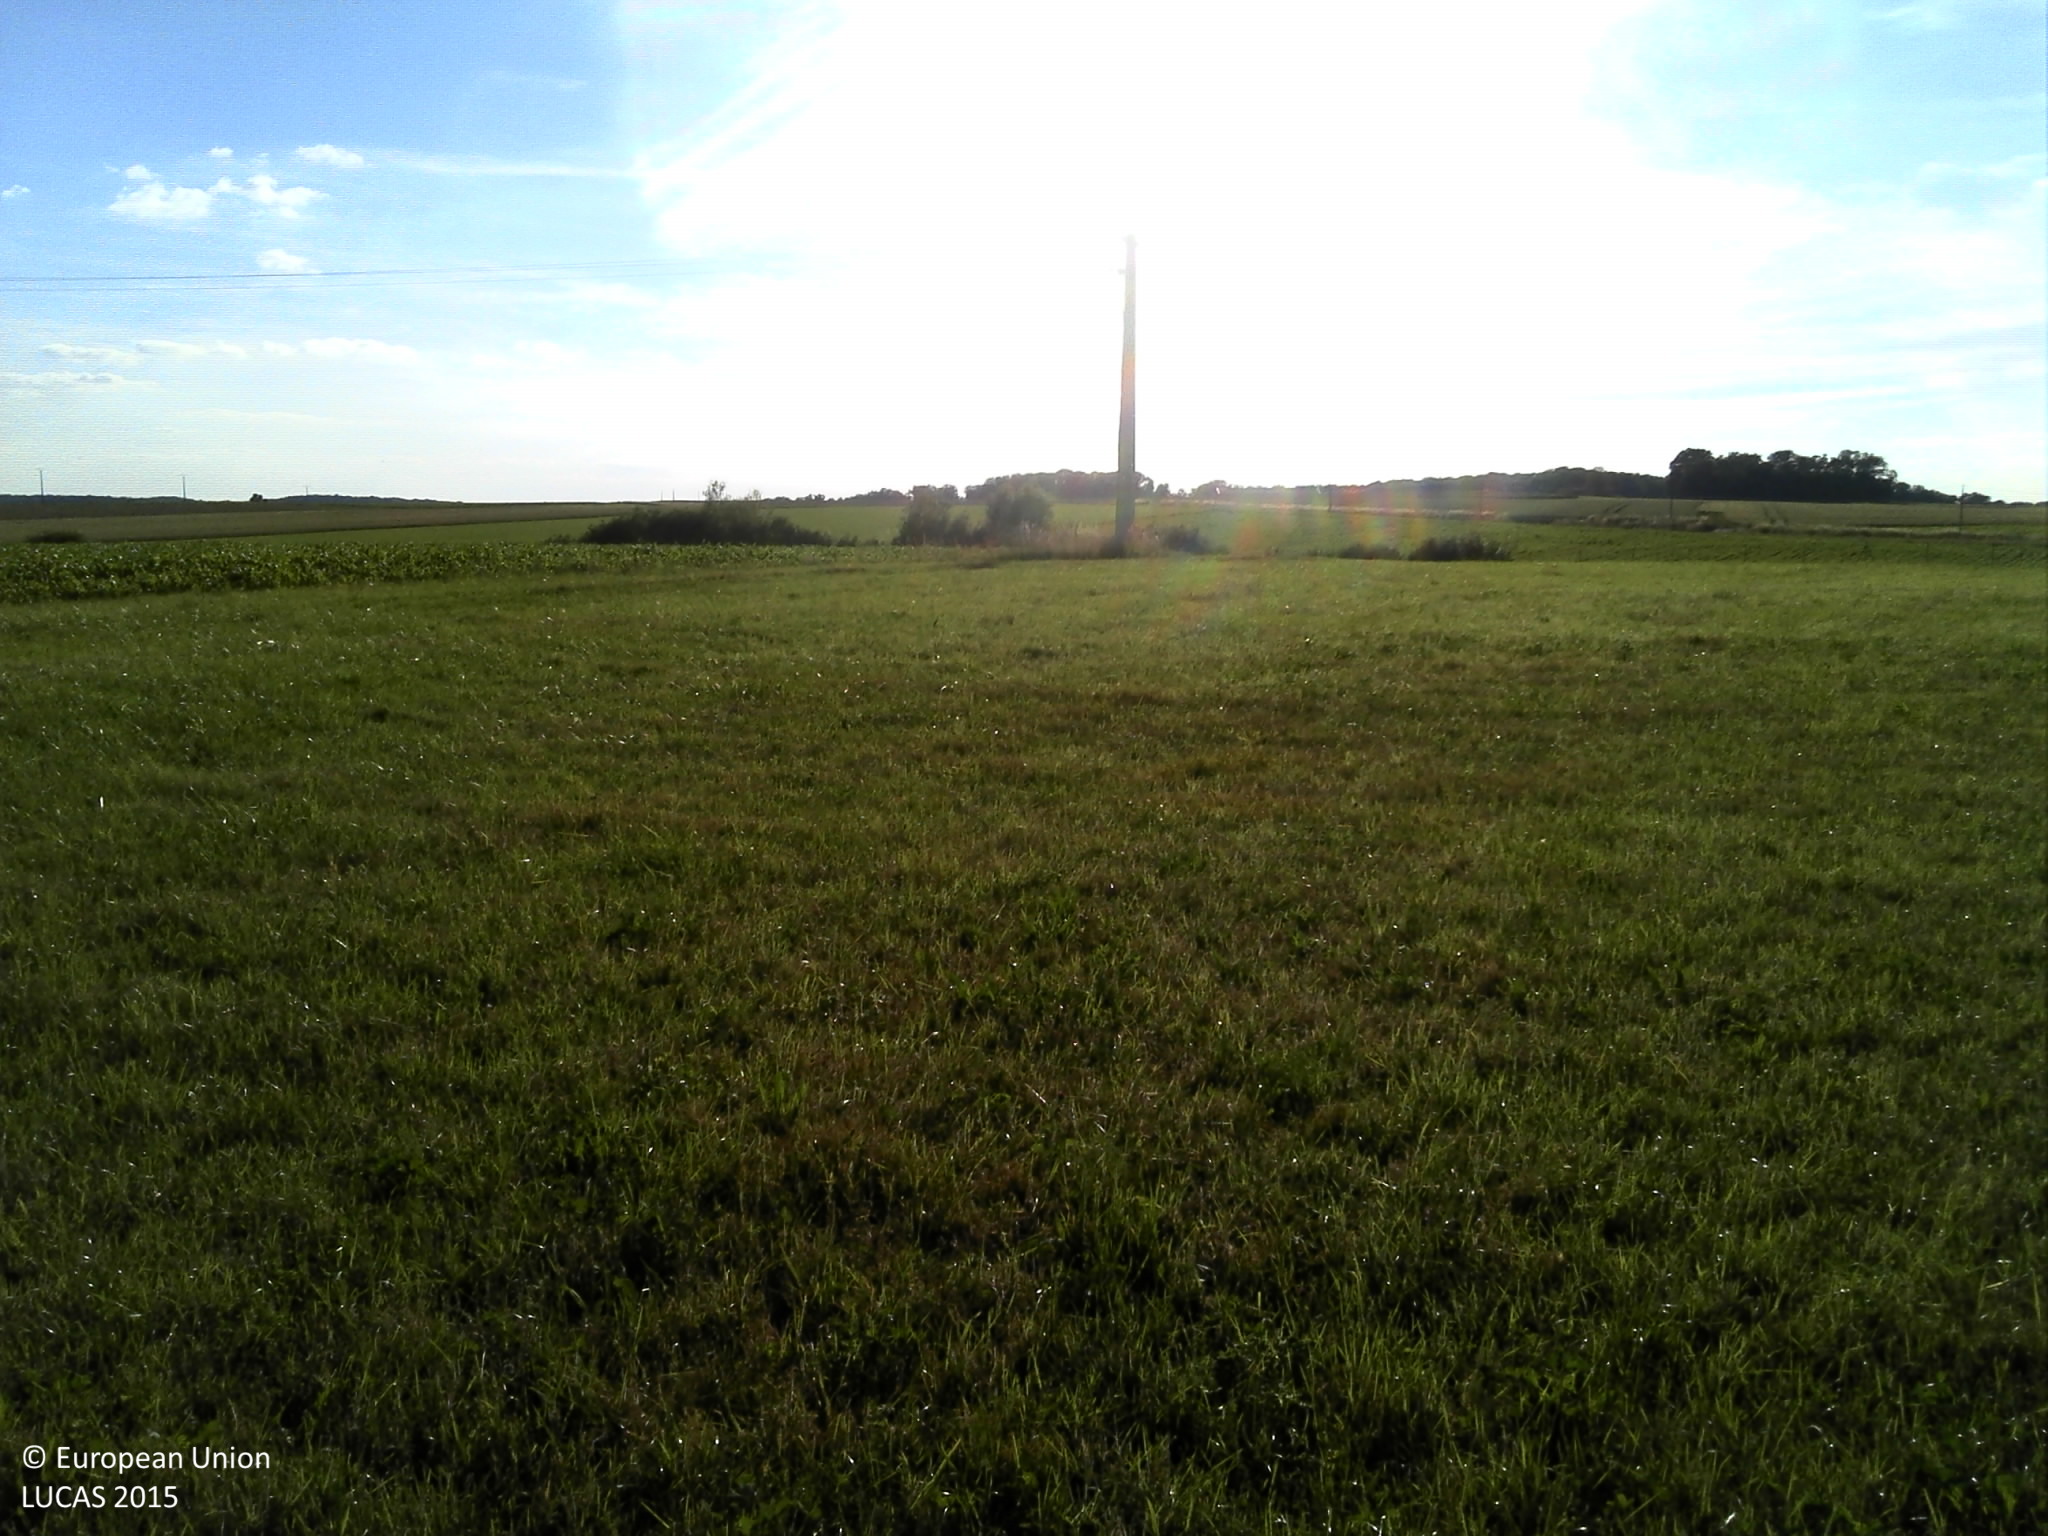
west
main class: Grassland
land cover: Grassland without tree/shrub cover
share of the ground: > 75 %
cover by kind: herbaceous plants 100 %
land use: Agriculture (excluding fallow land and kitchen gardens)
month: June
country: FR
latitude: 48.9511
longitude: 6.7913
